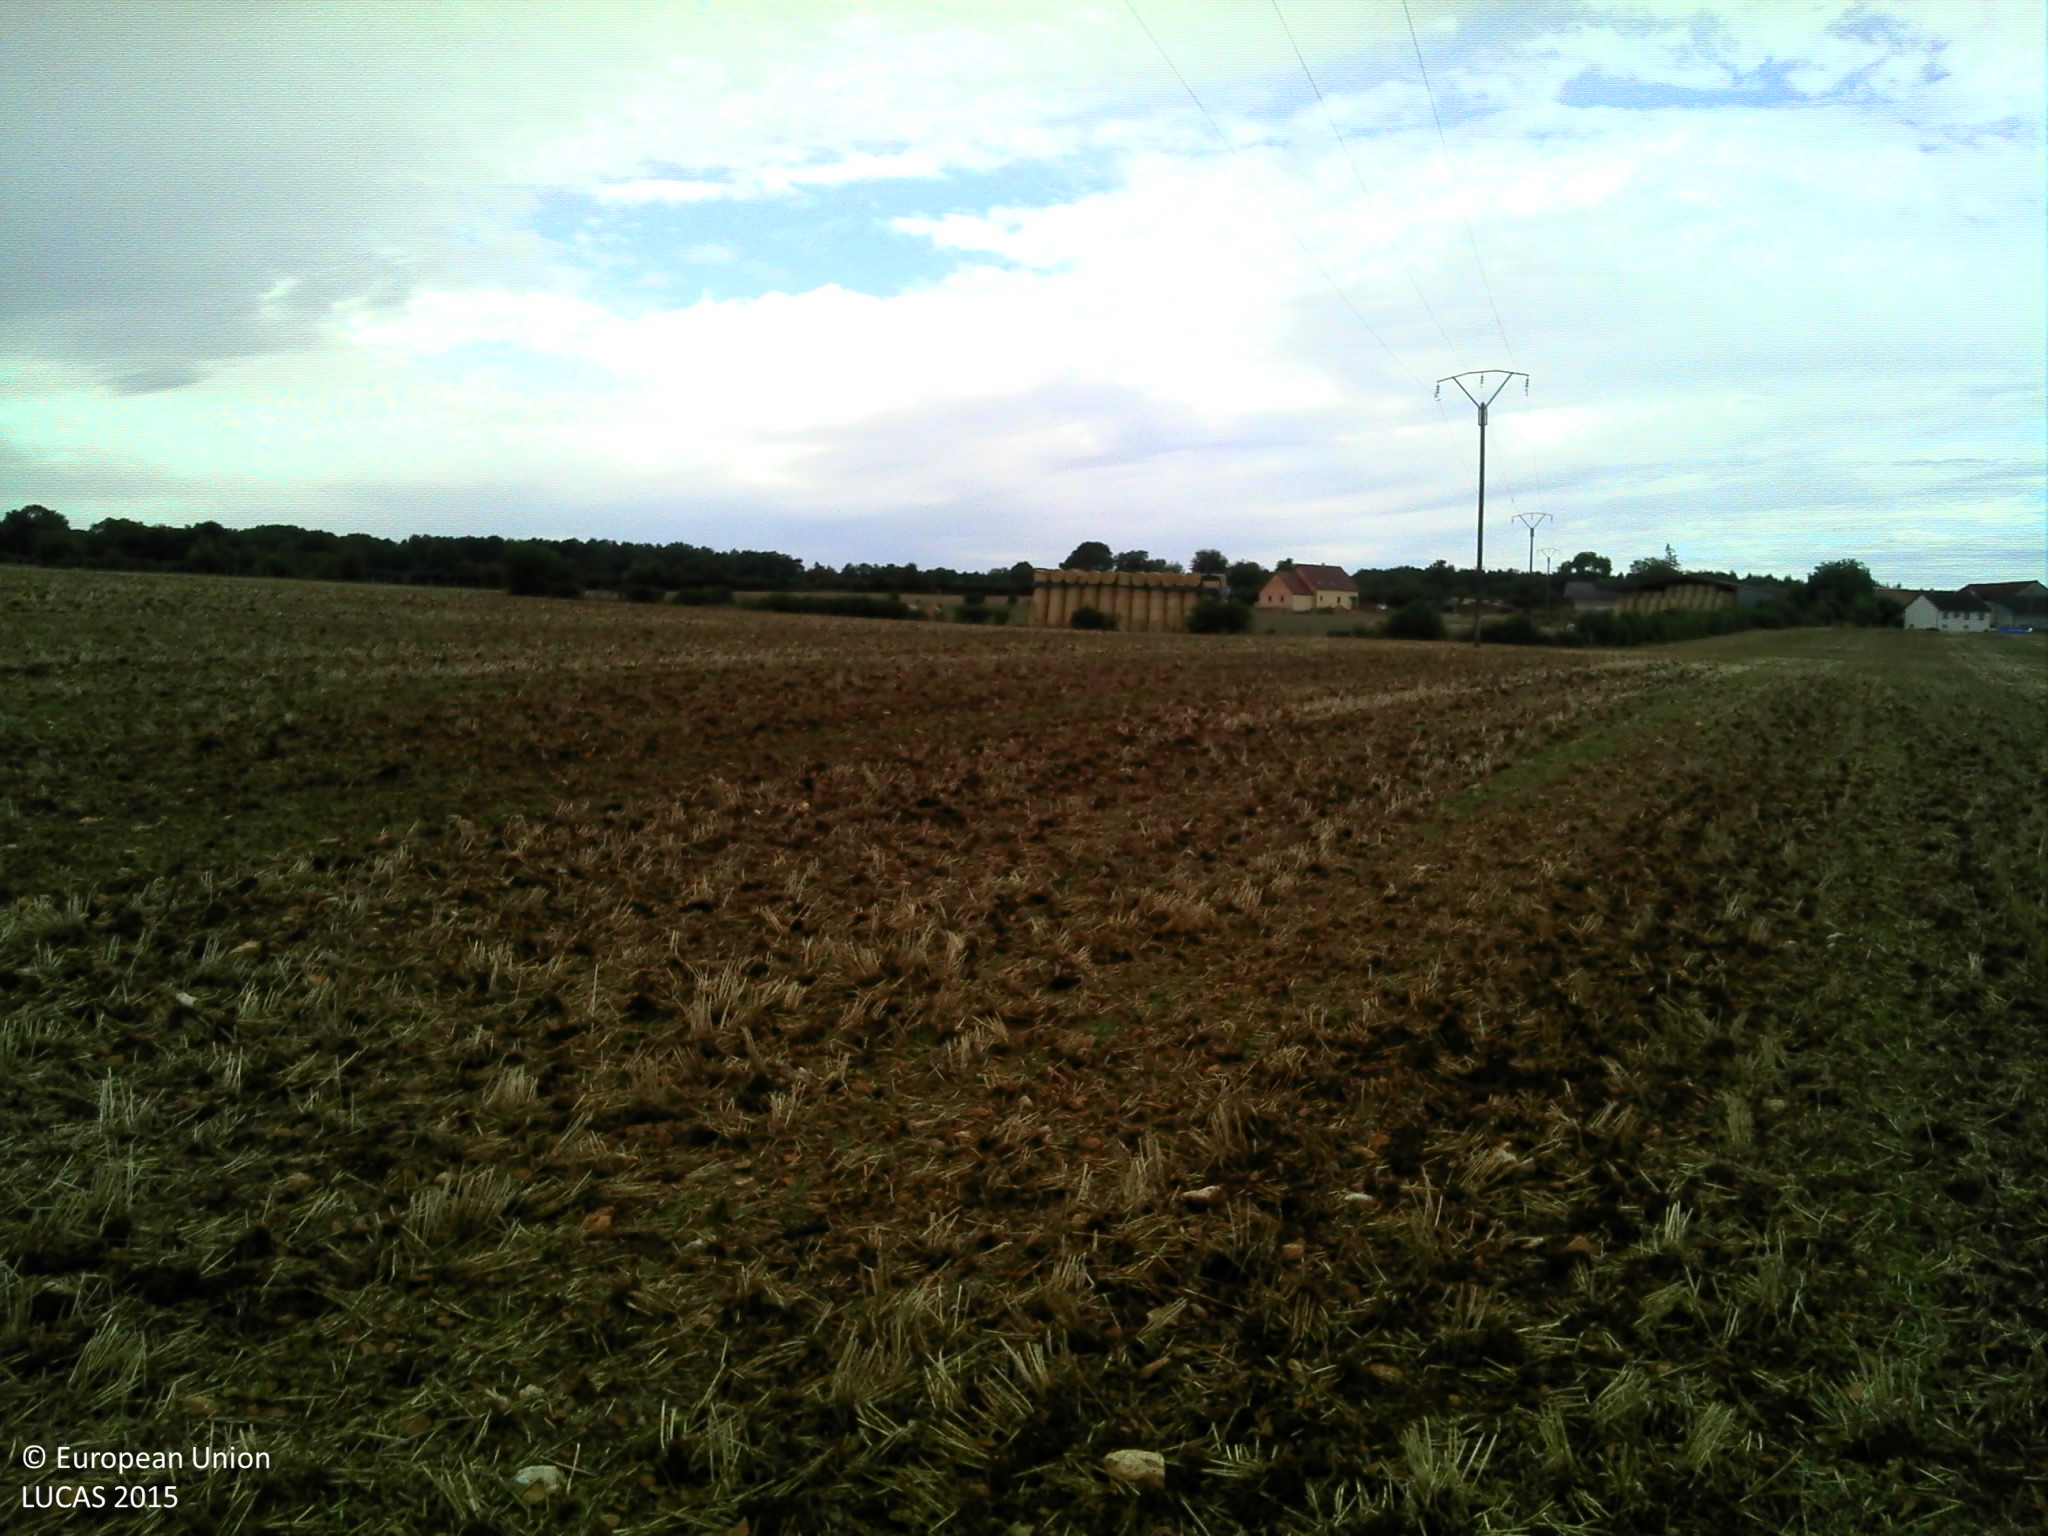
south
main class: Cropland
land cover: Common wheat
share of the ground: 10 - 25 %
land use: Agriculture (excluding fallow land and kitchen gardens)
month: August
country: FR
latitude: 47.8972
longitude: 4.6884
